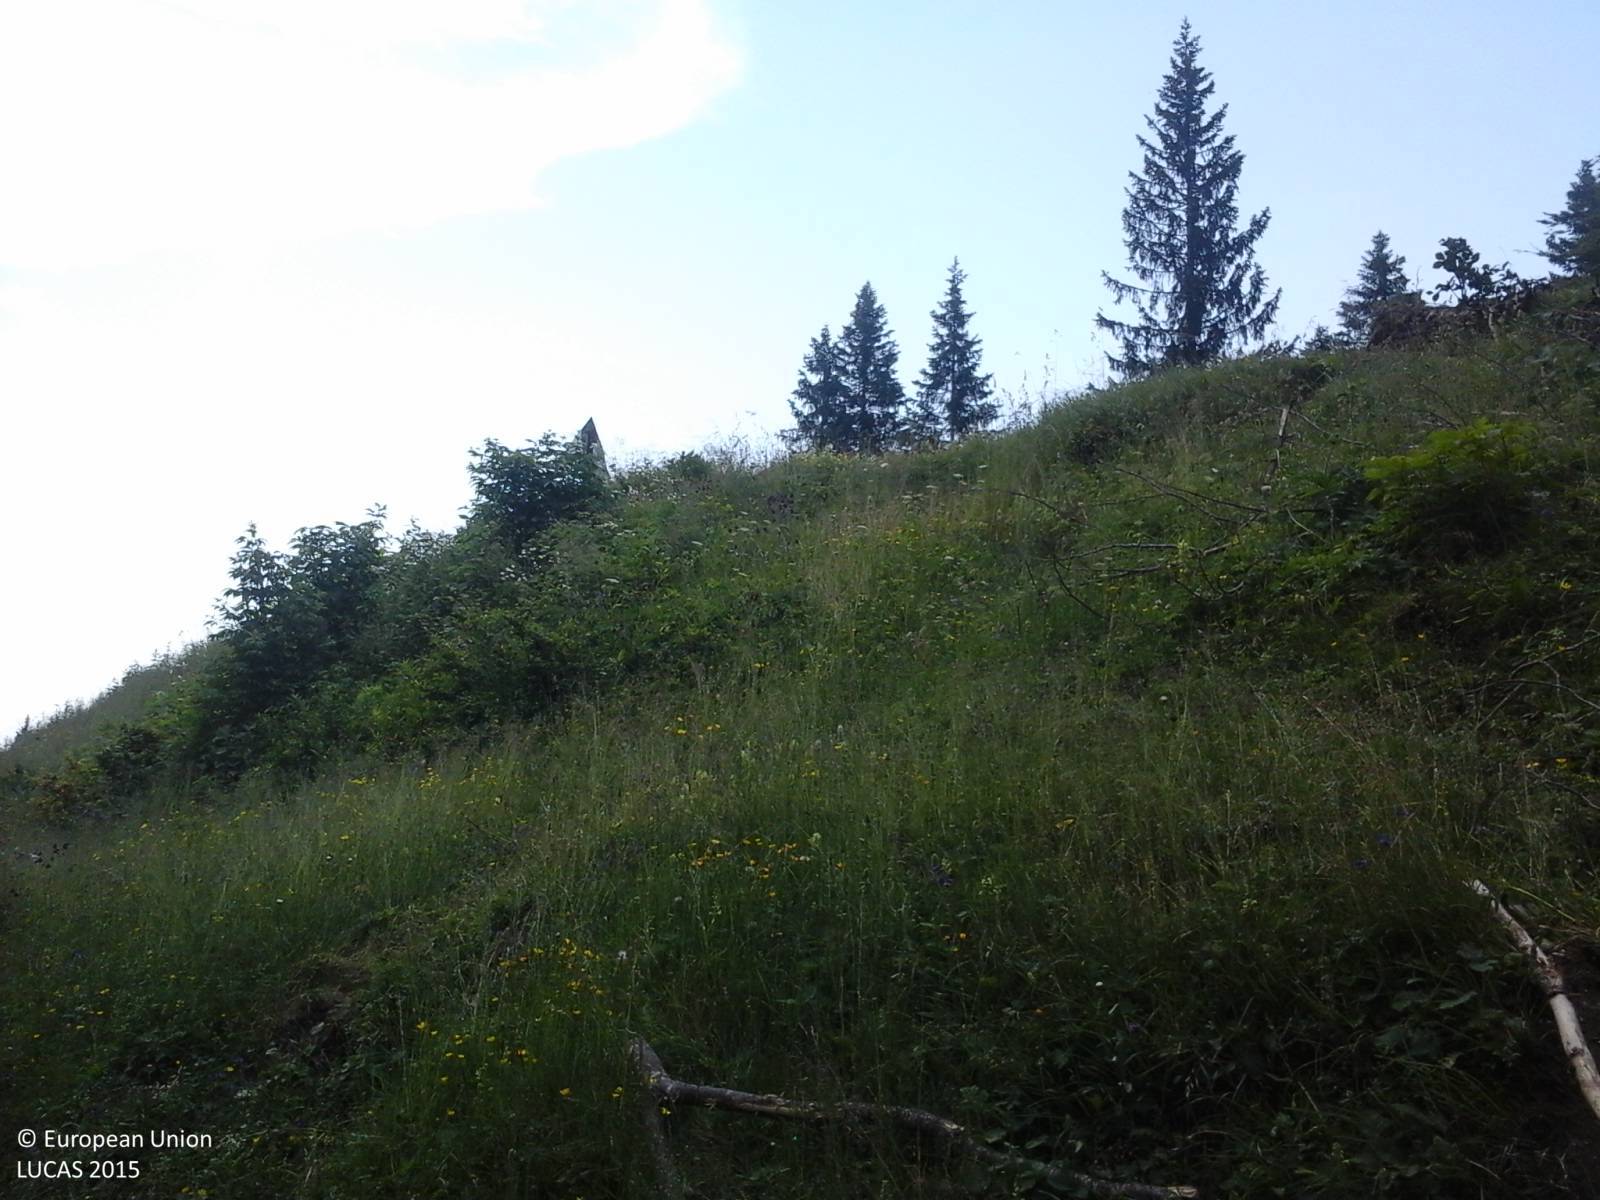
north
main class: Grassland
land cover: Grassland without tree/shrub cover
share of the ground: > 75 %
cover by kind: herbaceous plants 100 %
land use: Agriculture (excluding fallow land and kitchen gardens)
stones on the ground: 10 - 25 %
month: July
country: IT
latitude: 46.4242
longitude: 12.7427
